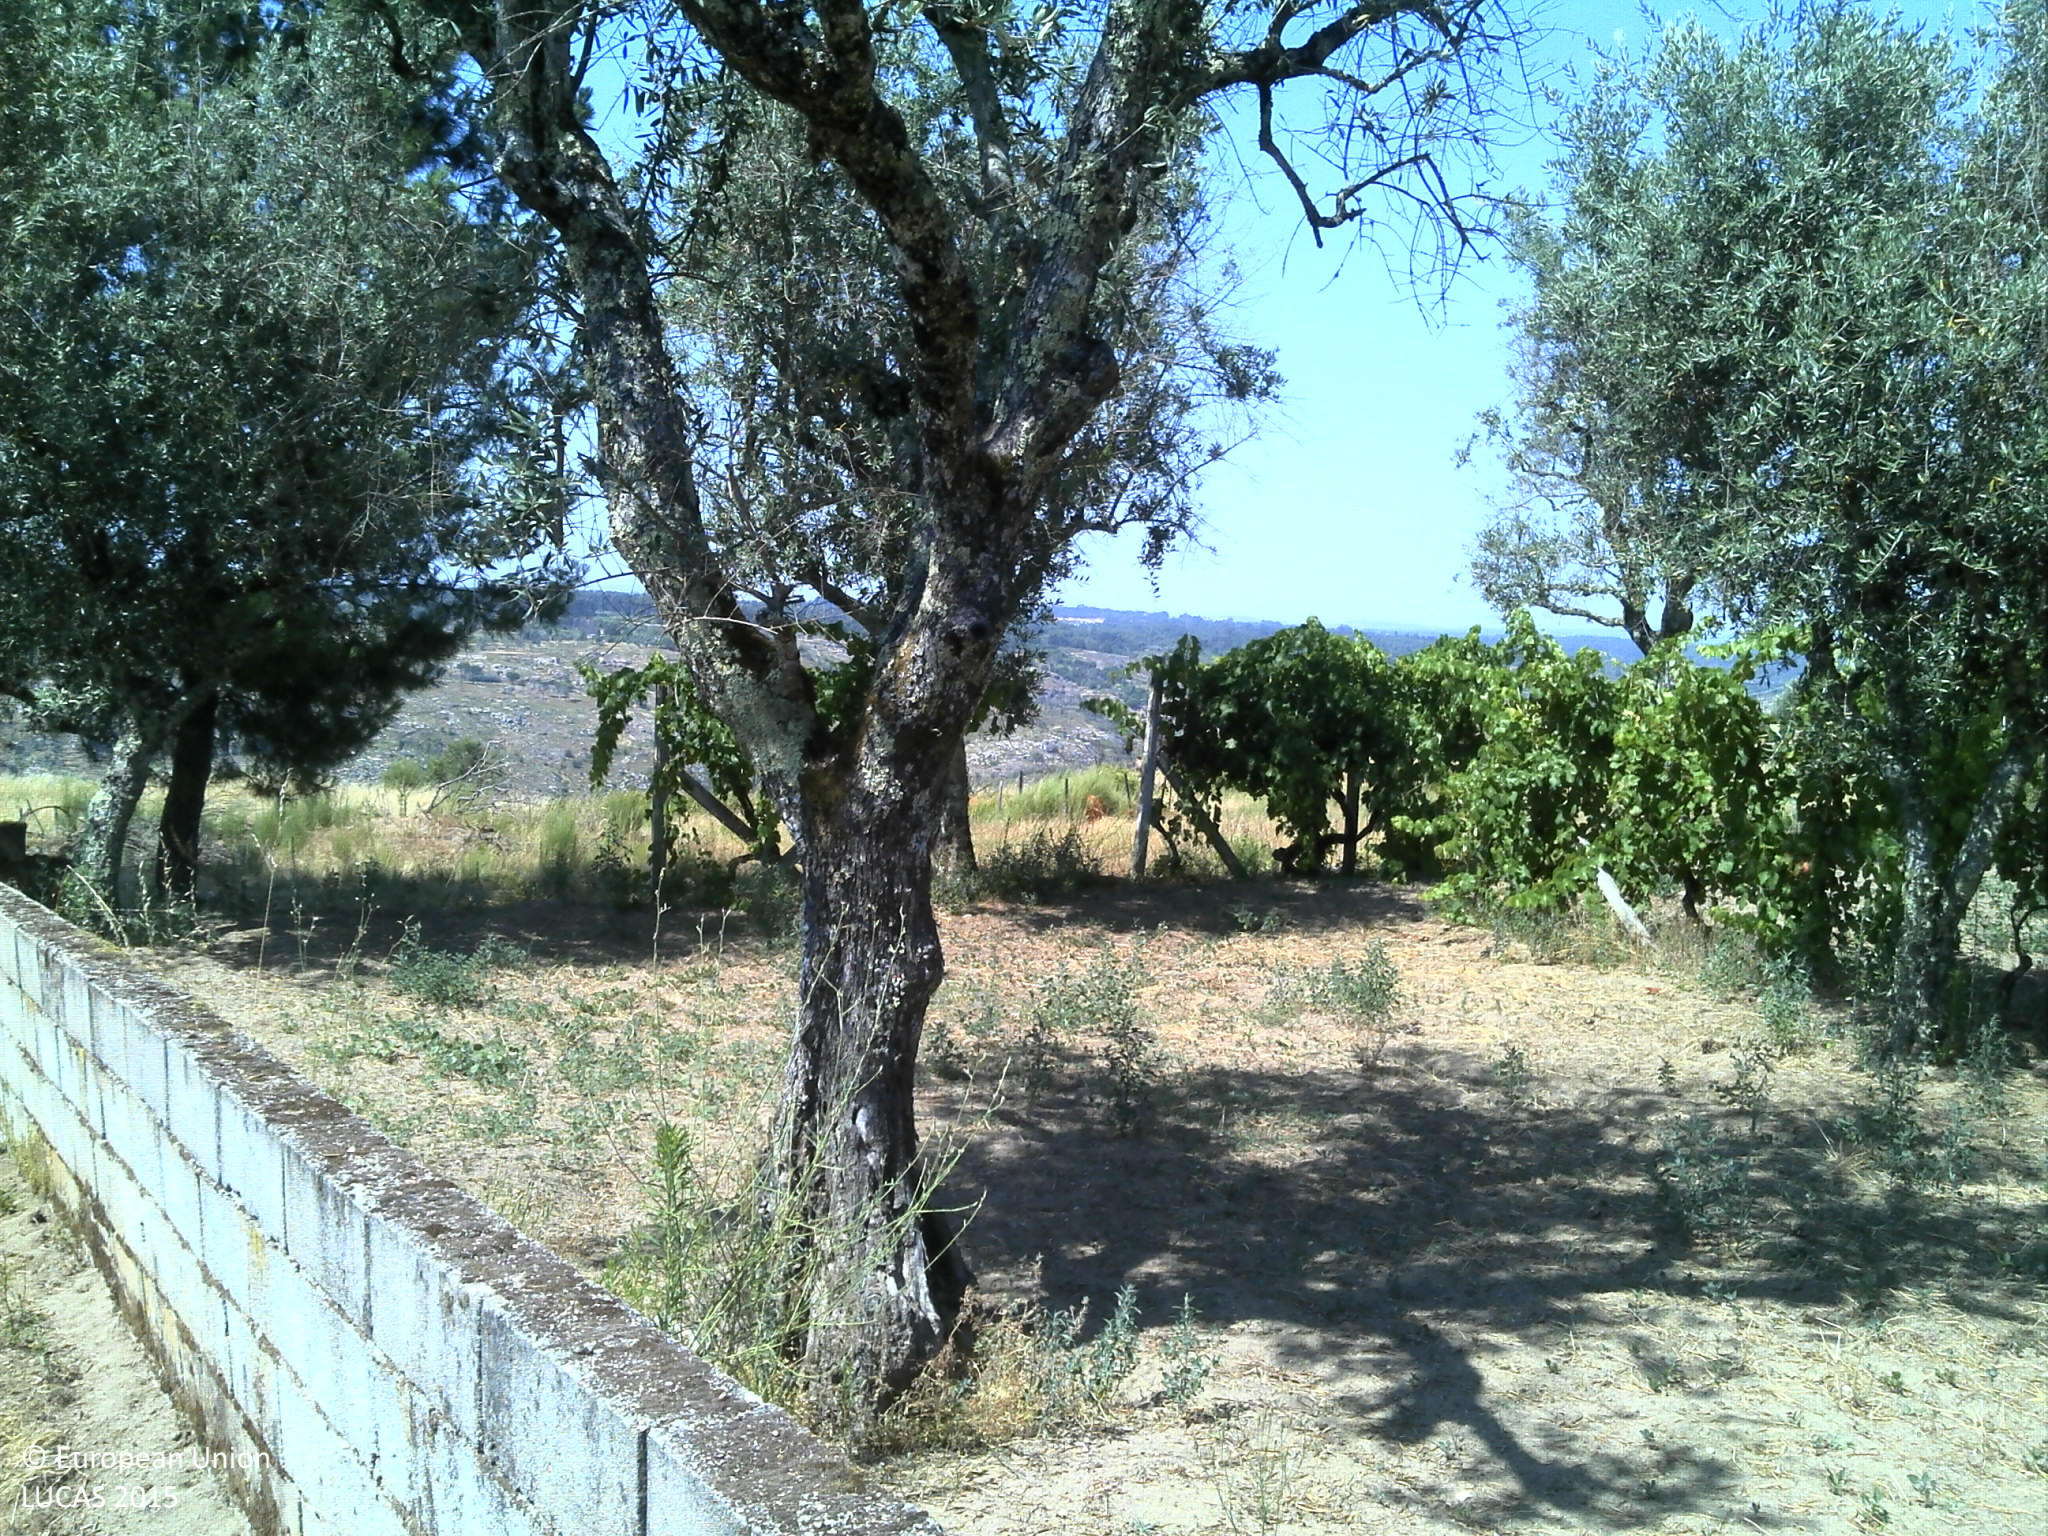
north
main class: Cropland
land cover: Olive groves
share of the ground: 25 - 50 %
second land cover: Grassland without tree/shrub cover
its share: 10 - 25 %
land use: Agriculture (excluding fallow land and kitchen gardens)
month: July
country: PT
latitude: 40.4024
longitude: -7.8755
